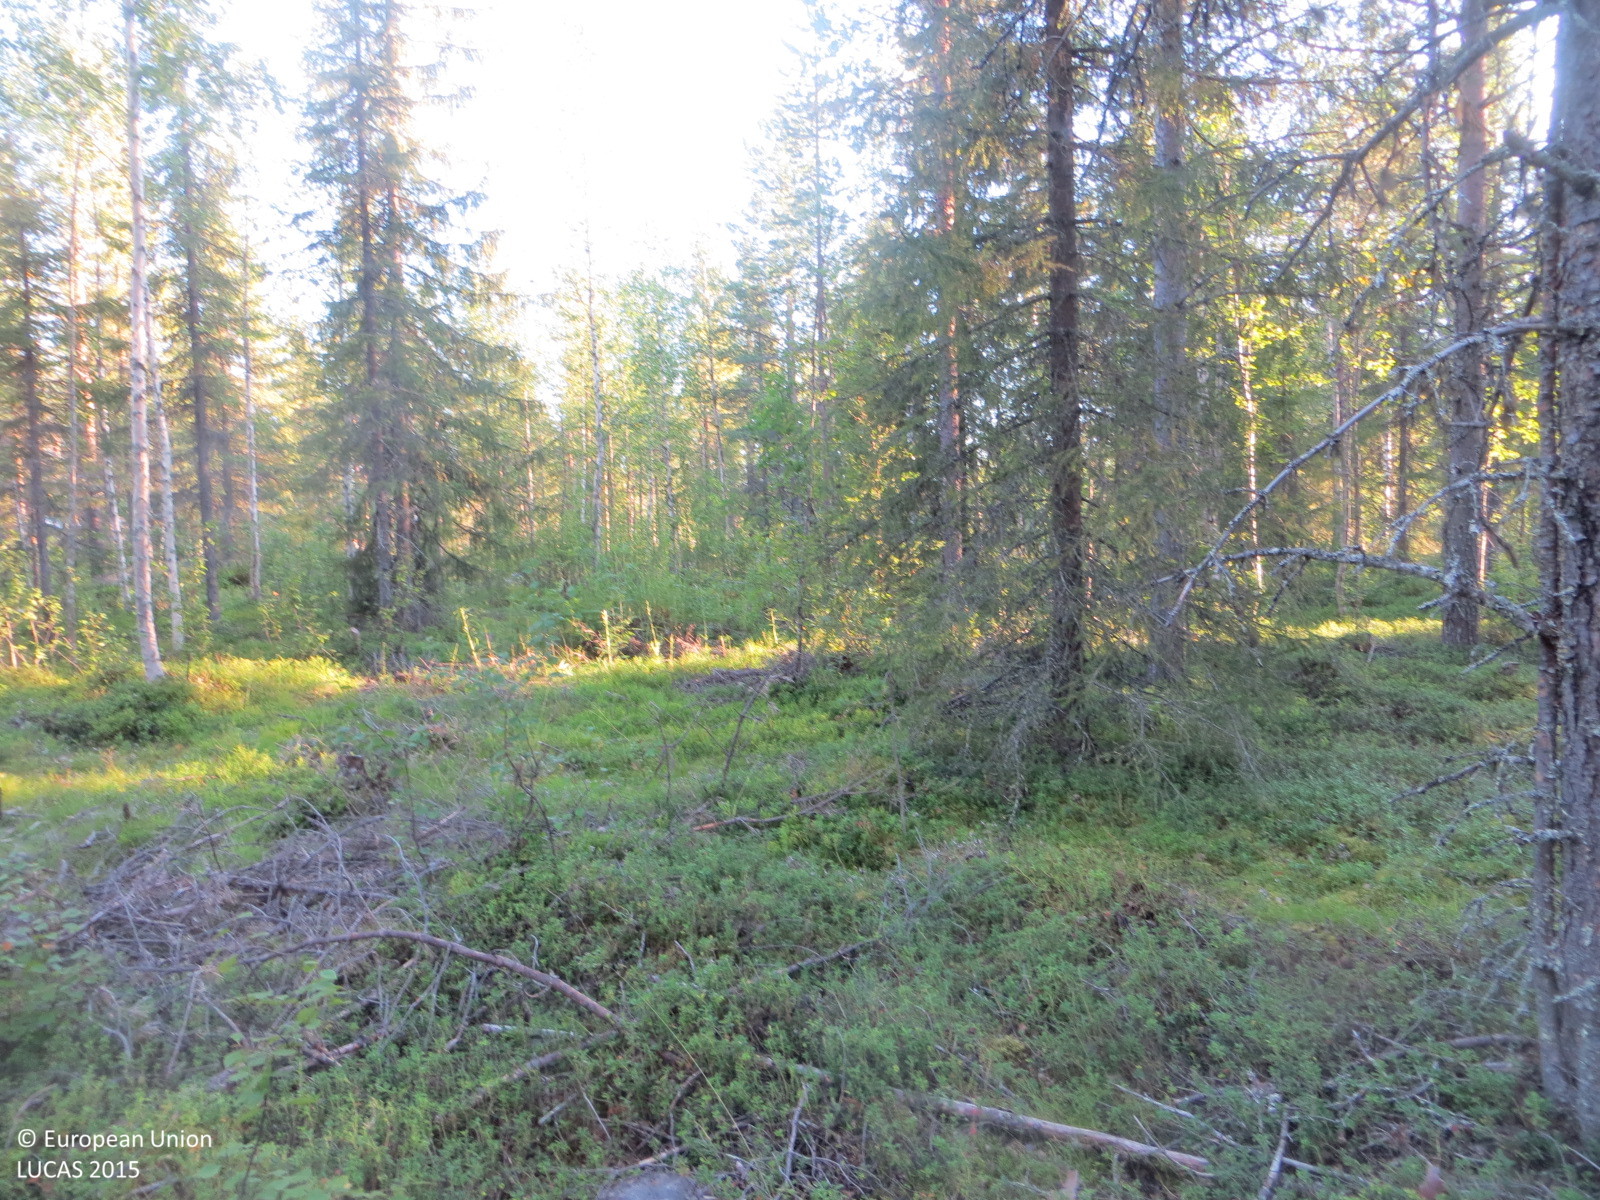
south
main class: Woodland
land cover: Other mixed woodland
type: boreal forest
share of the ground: 50 - 75 %
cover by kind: shrubs 50 %, coniferous forest trees 30 %, broadleaved forest trees 20 %
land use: Forestry
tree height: > 5 m
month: August
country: FI
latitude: 67.2689
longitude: 23.8692
